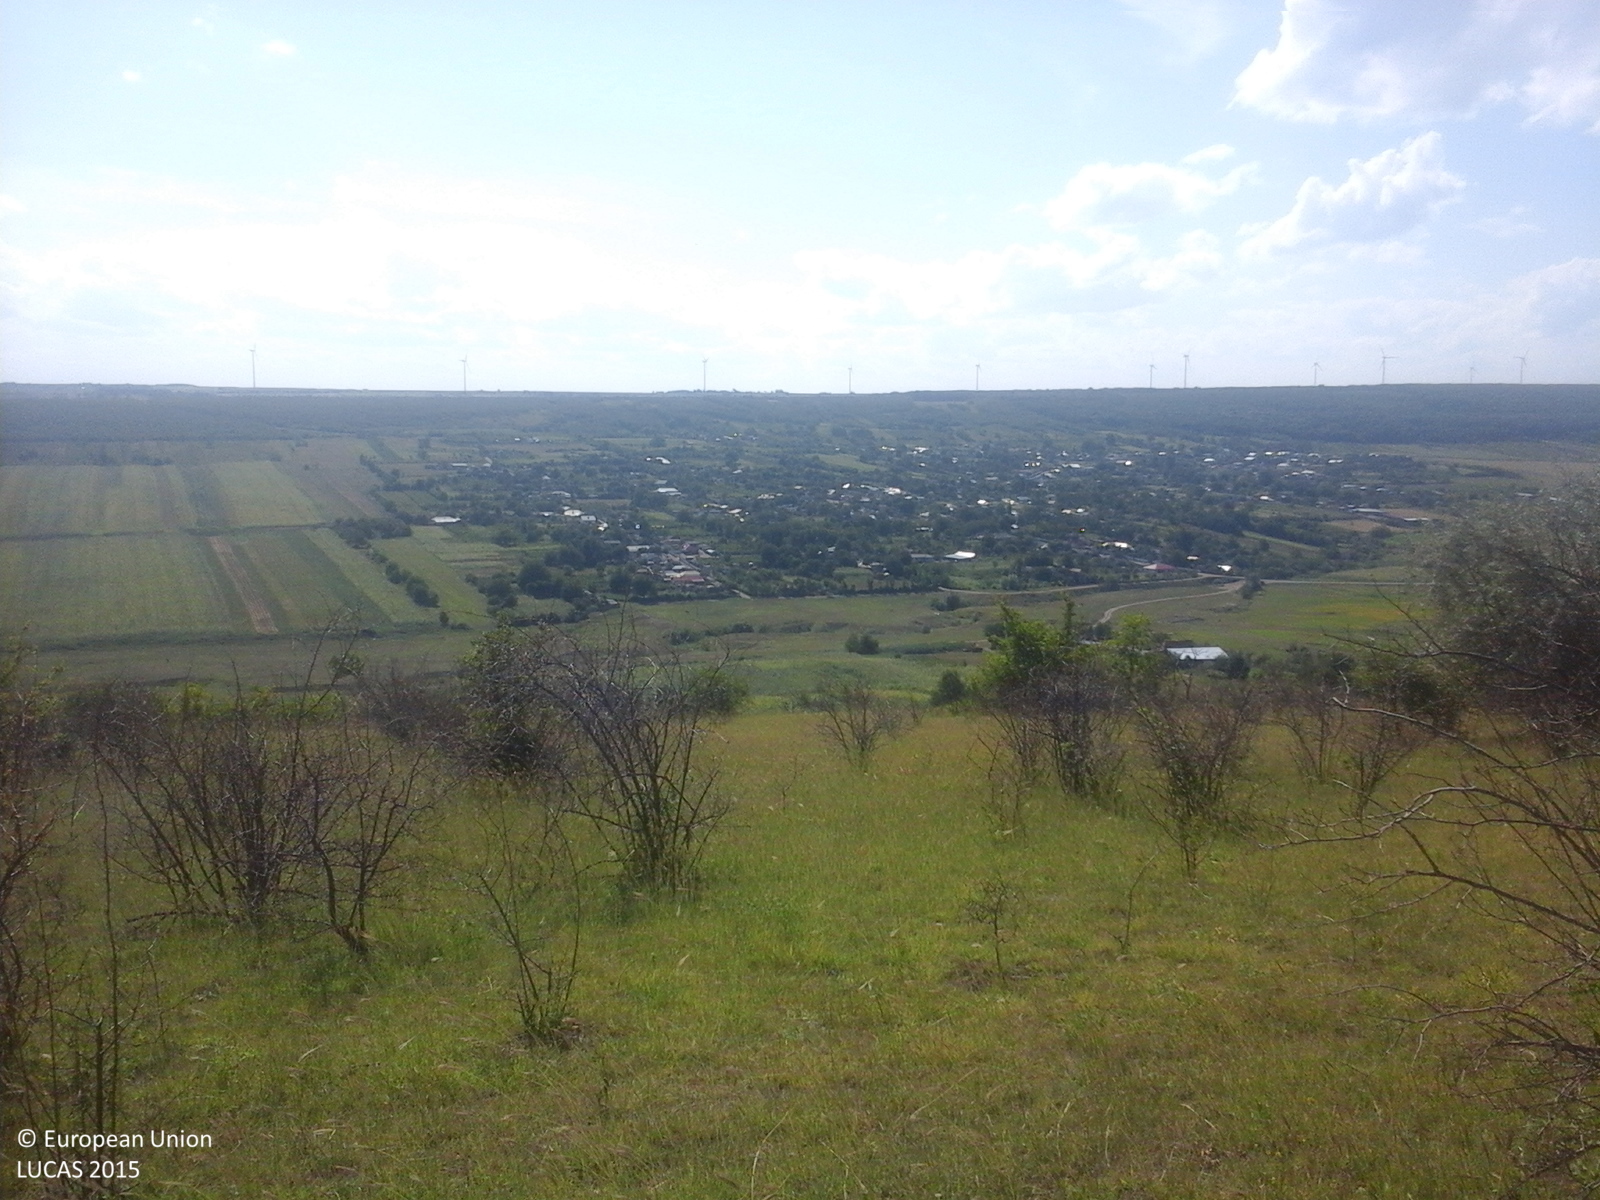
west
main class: Grassland
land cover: Grassland with sparse tree/shrub cover
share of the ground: > 75 %
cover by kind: herbaceous plants 85 %, shrubs 10 %, broadleaved forest trees 5 %
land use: Agriculture (excluding fallow land and kitchen gardens)
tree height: < 5 m
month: July
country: RO
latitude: 46.4879
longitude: 27.9864
